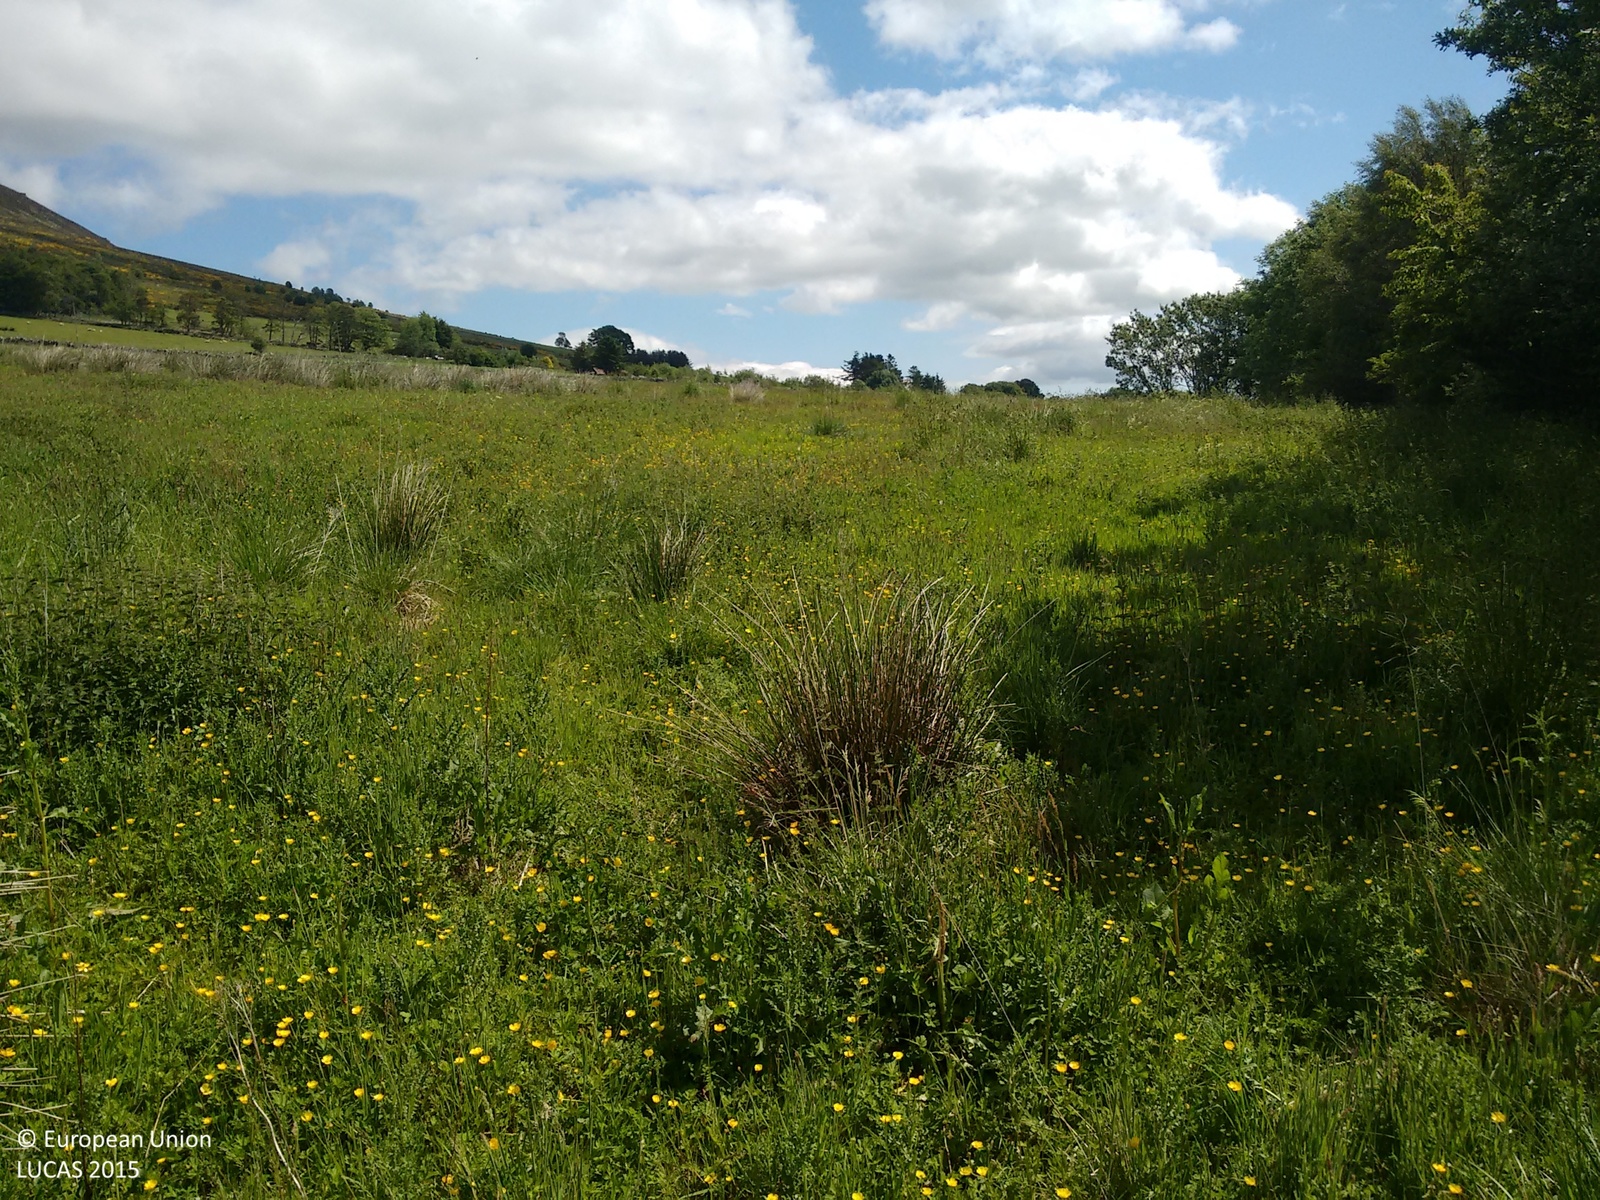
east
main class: Grassland
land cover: Grassland without tree/shrub cover
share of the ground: > 75 %
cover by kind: herbaceous plants 100 %
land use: Agriculture (excluding fallow land and kitchen gardens)
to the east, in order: Grassland without tree/shrub cover; Fences; Broadleaved woodland; Grassland without tree/shrub cover; Fences; Dry stone walls; Grass margins; Fences; Barley
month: June
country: GB
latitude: 57.3419
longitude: -2.8702
